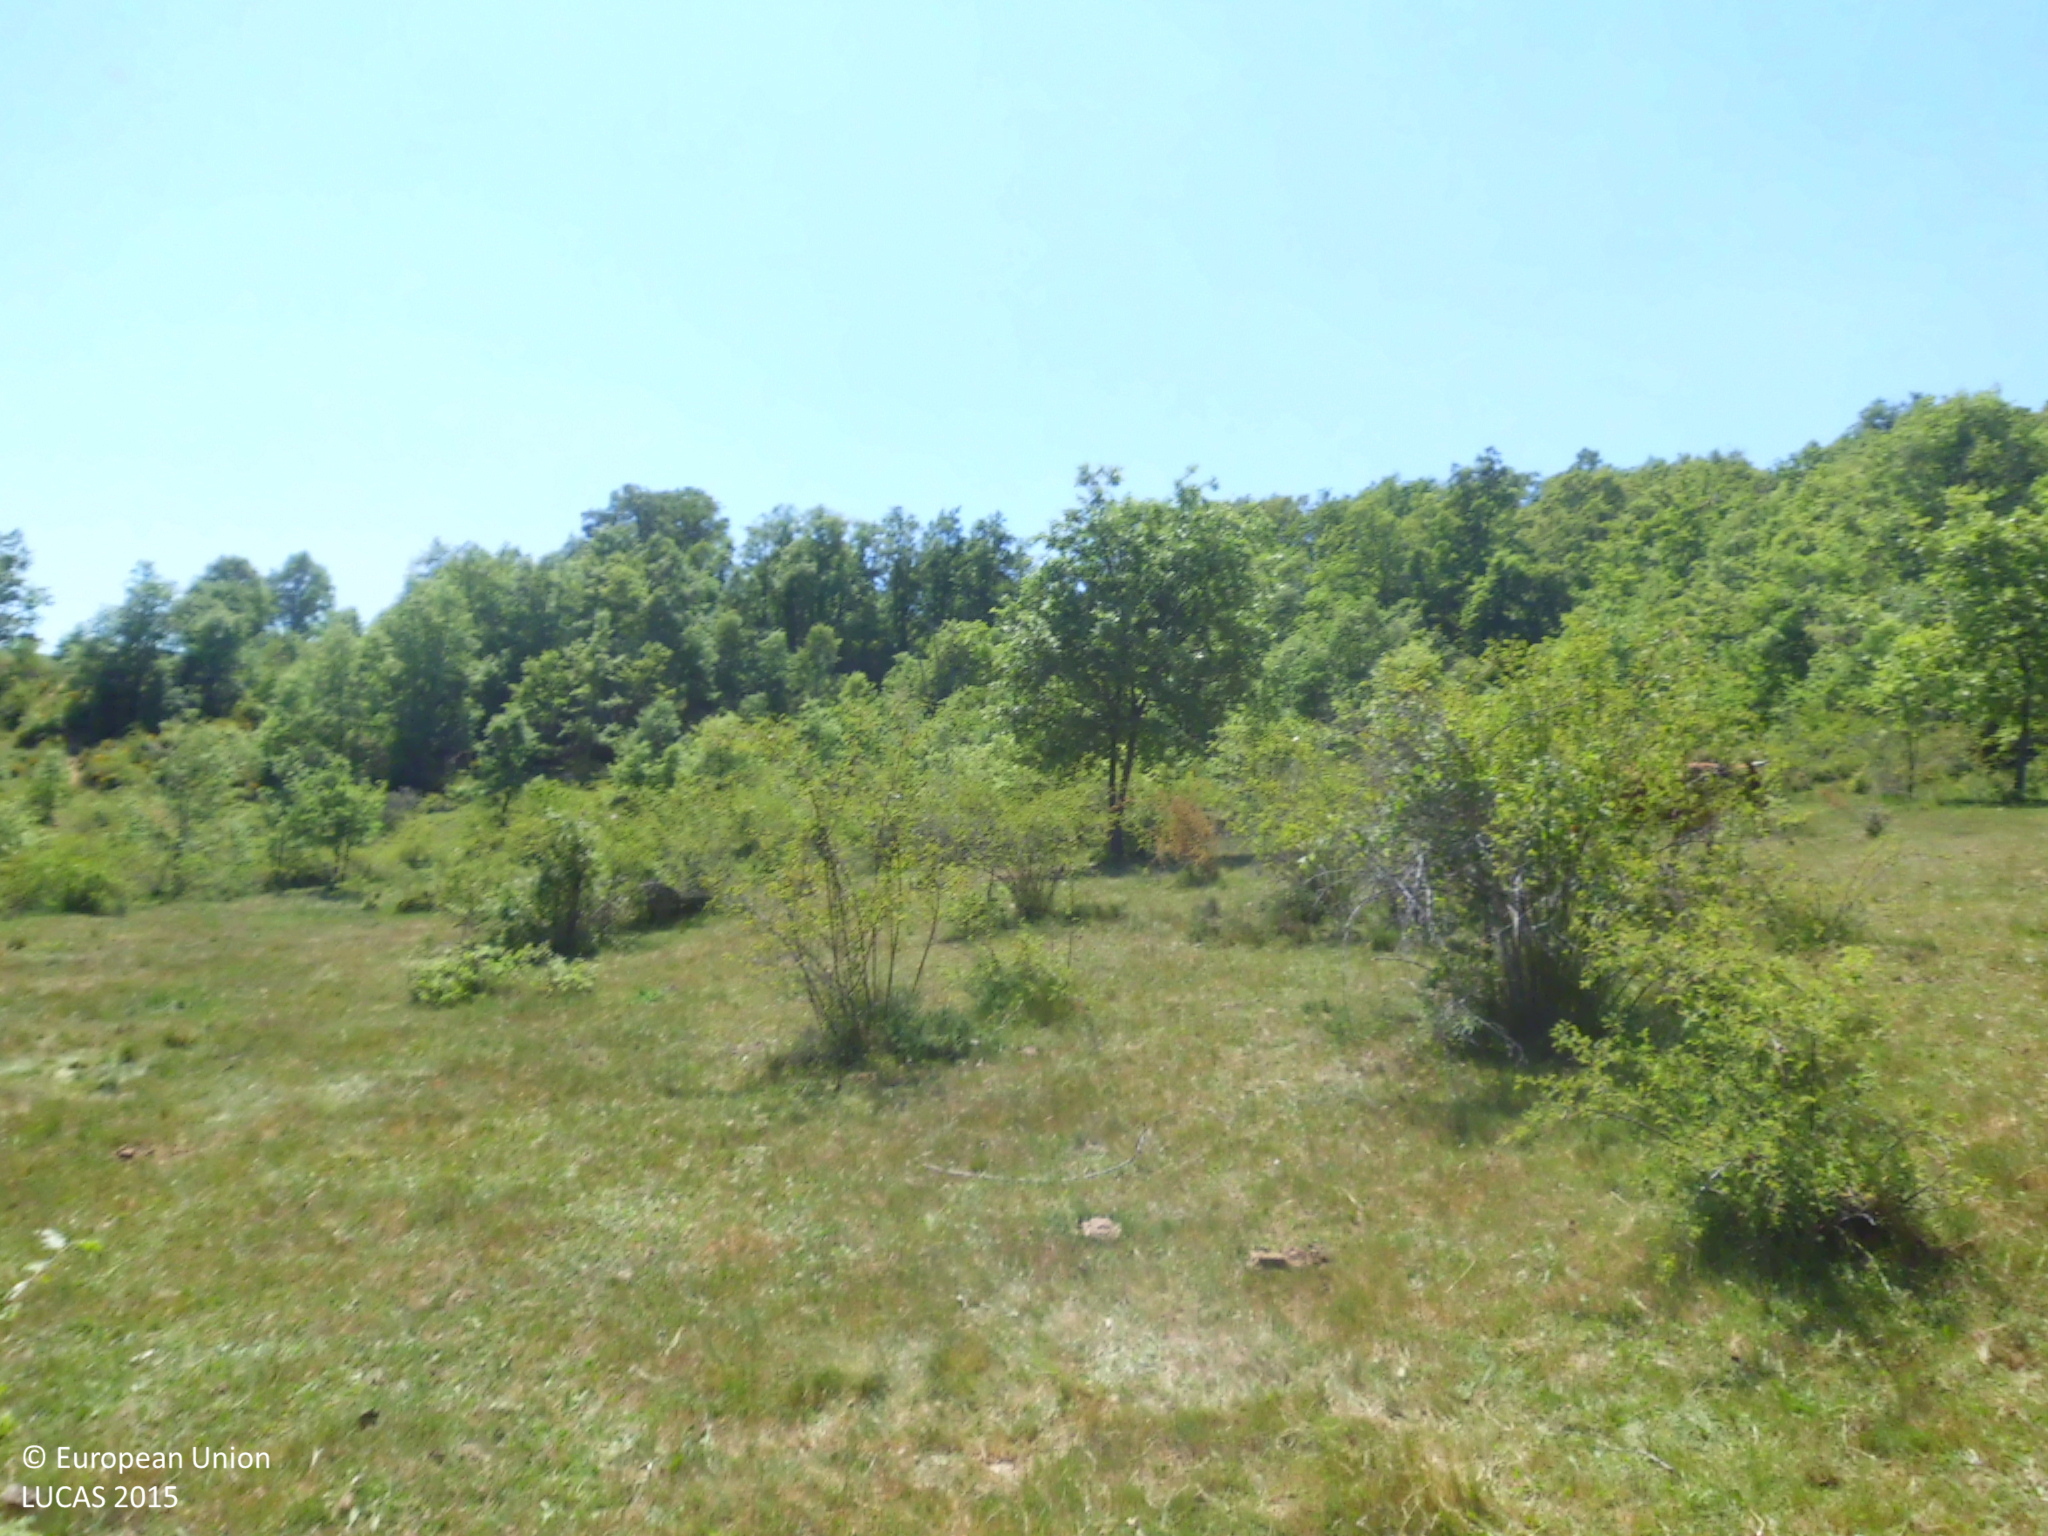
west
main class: Grassland
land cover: Grassland with sparse tree/shrub cover
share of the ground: > 75 %
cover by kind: herbaceous plants 90 %, broadleaved forest trees 5 %, shrubs 5 %
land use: Agriculture (excluding fallow land and kitchen gardens)
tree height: < 5 m
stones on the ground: > 50 %
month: May
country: ES
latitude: 42.8576
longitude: -5.4323
